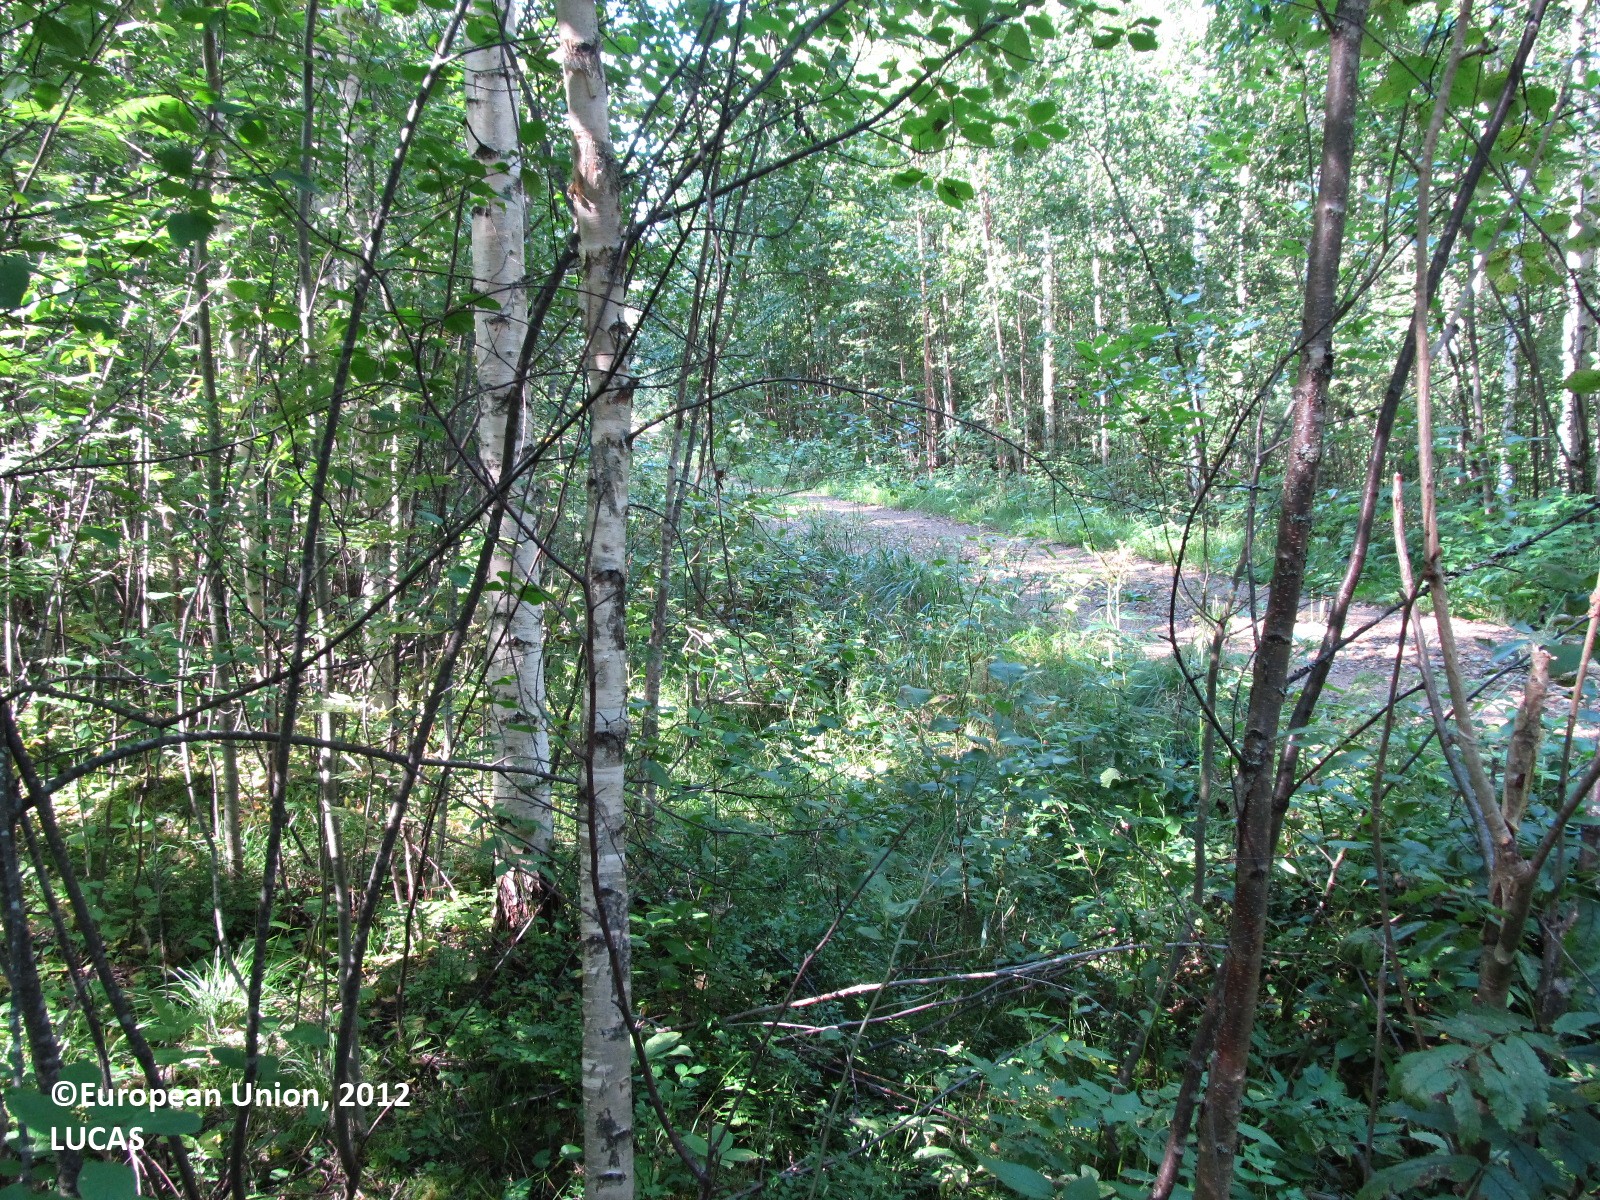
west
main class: Woodland
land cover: Broadleaved woodland
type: boreal forest
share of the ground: 50 - 75 %
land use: Forestry
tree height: > 5 m
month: August
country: FI
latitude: 62.1791
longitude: 28.4691
